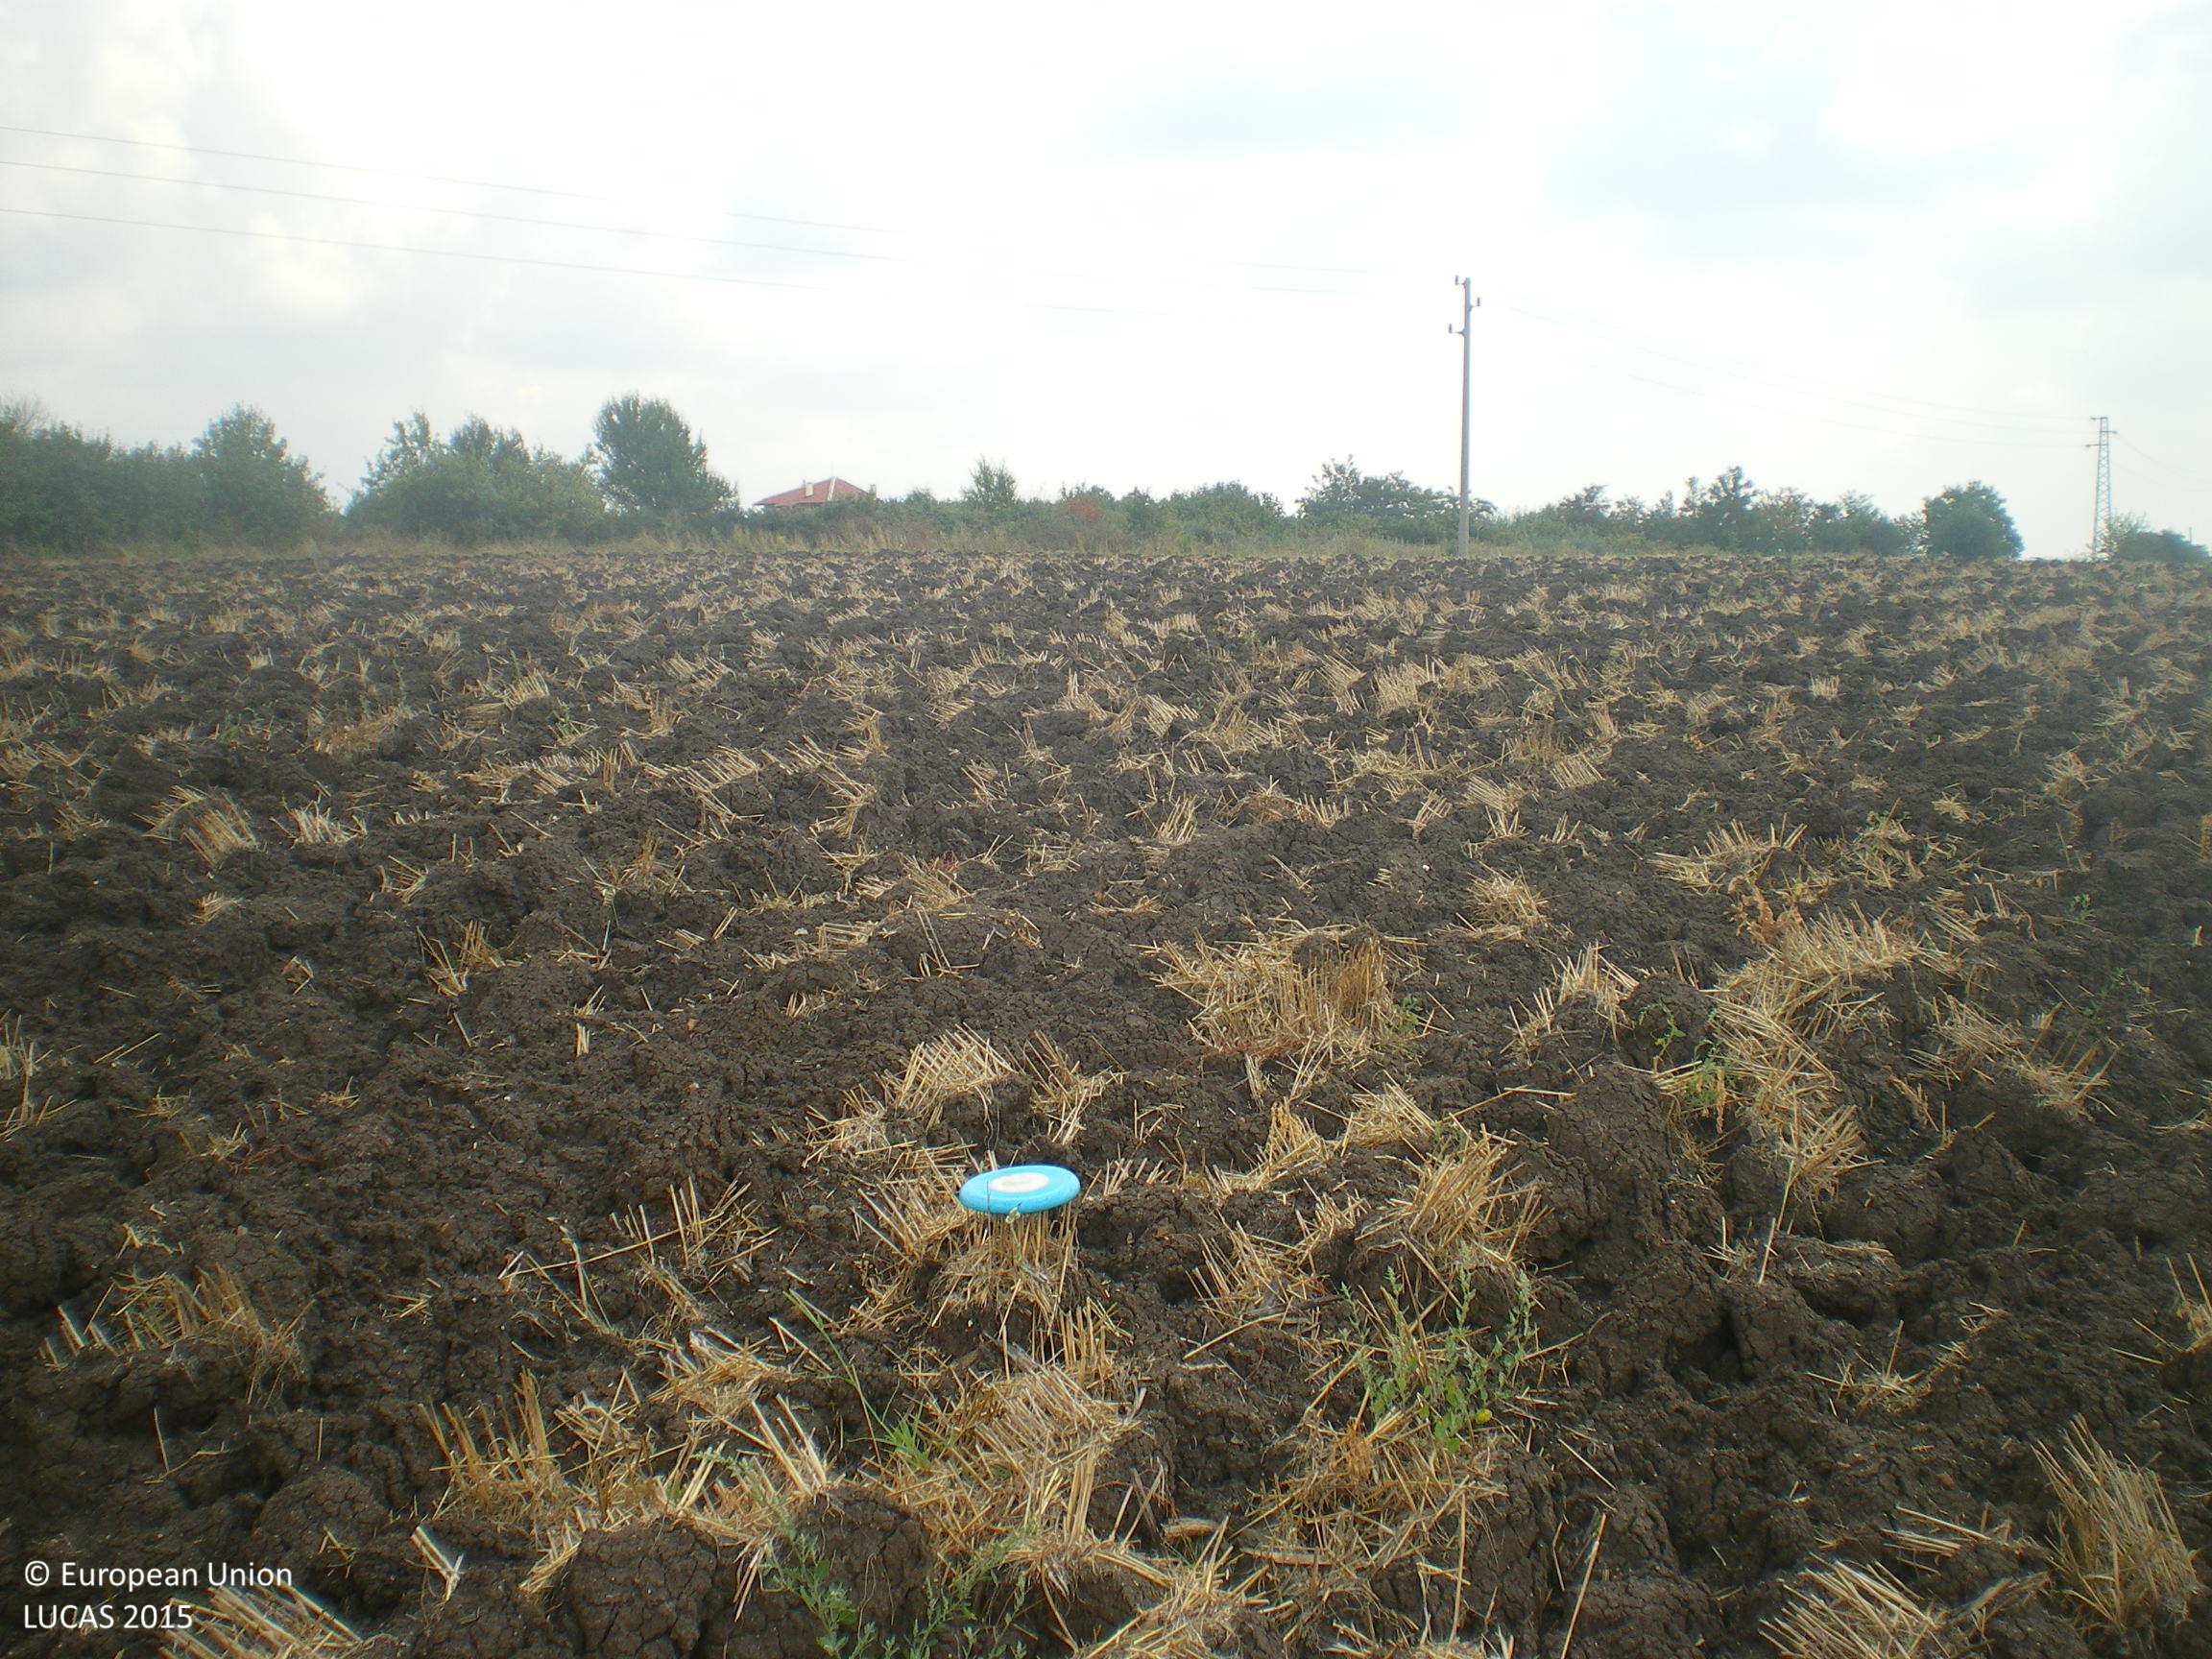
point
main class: Cropland
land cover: Common wheat
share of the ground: < 10 %
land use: Agriculture (excluding fallow land and kitchen gardens)
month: August
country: BG
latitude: 42.3174
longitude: 25.8361
